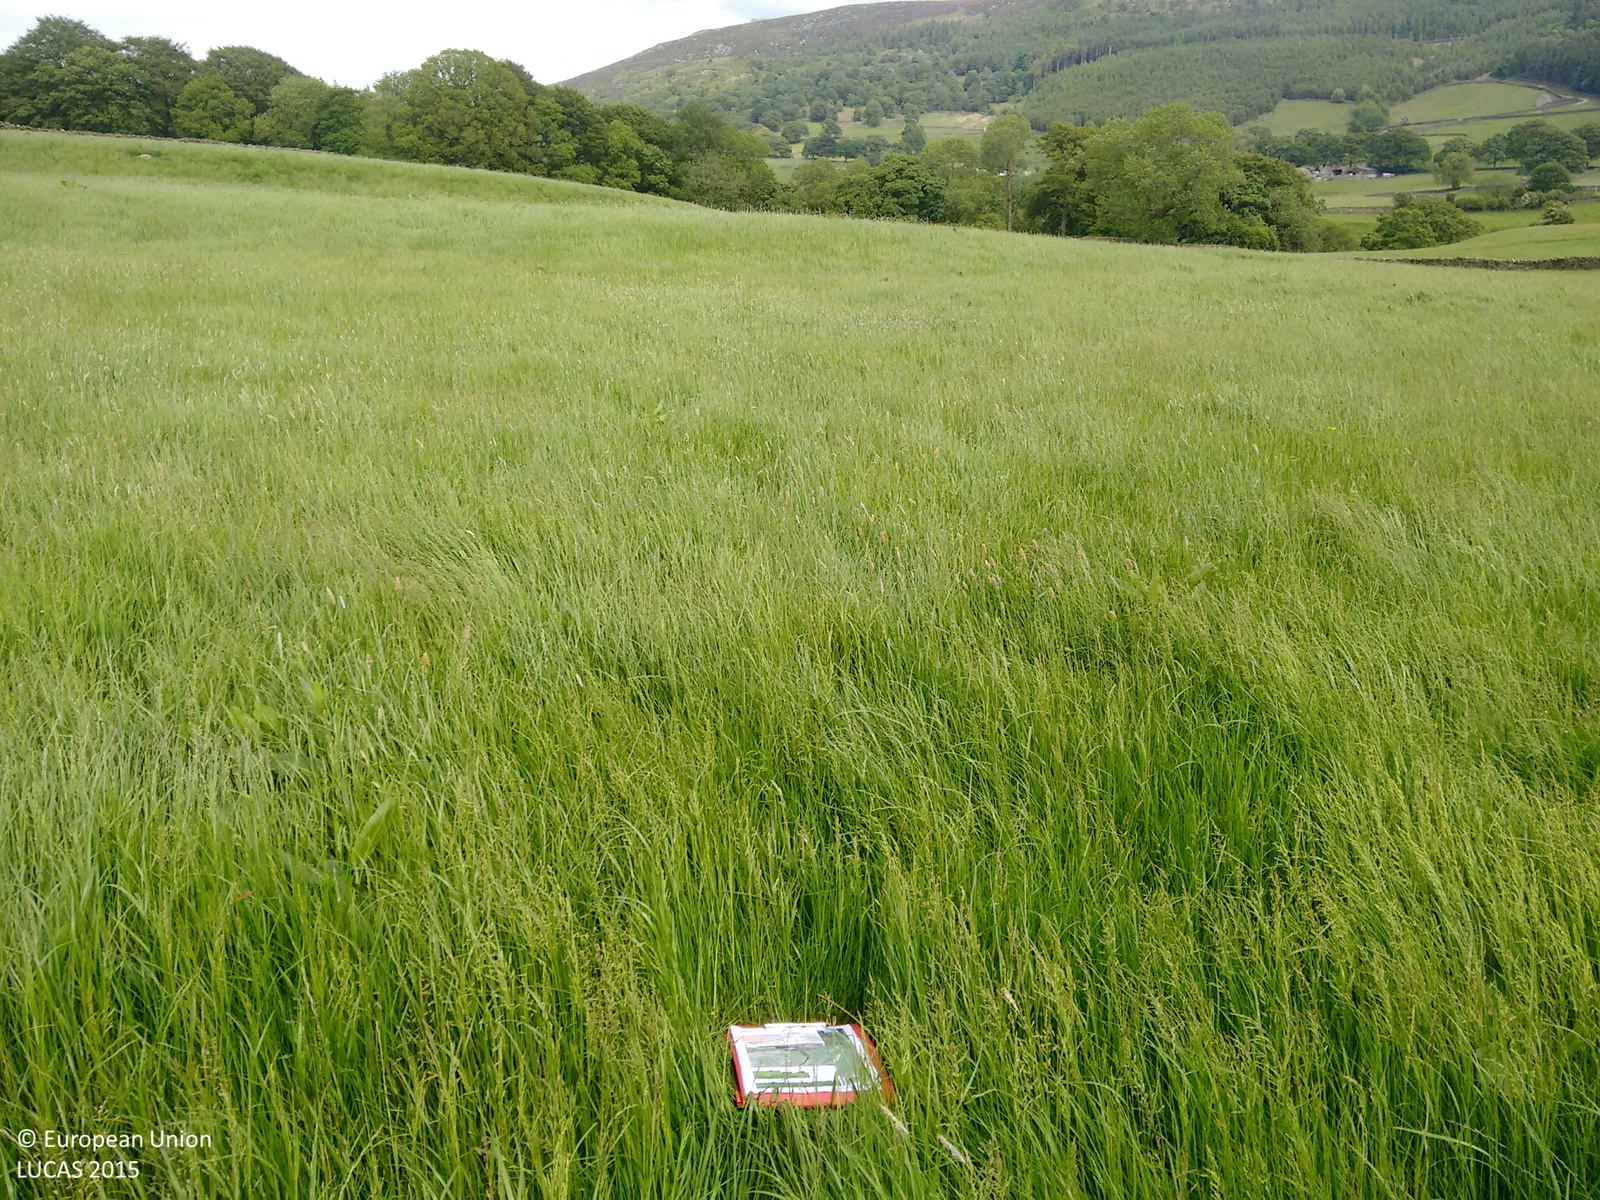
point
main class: Grassland
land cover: Grassland without tree/shrub cover
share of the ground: > 75 %
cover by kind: herbaceous plants 100 %
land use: Agriculture (excluding fallow land and kitchen gardens)
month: June
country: GB
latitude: 54.0292
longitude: -1.9174
